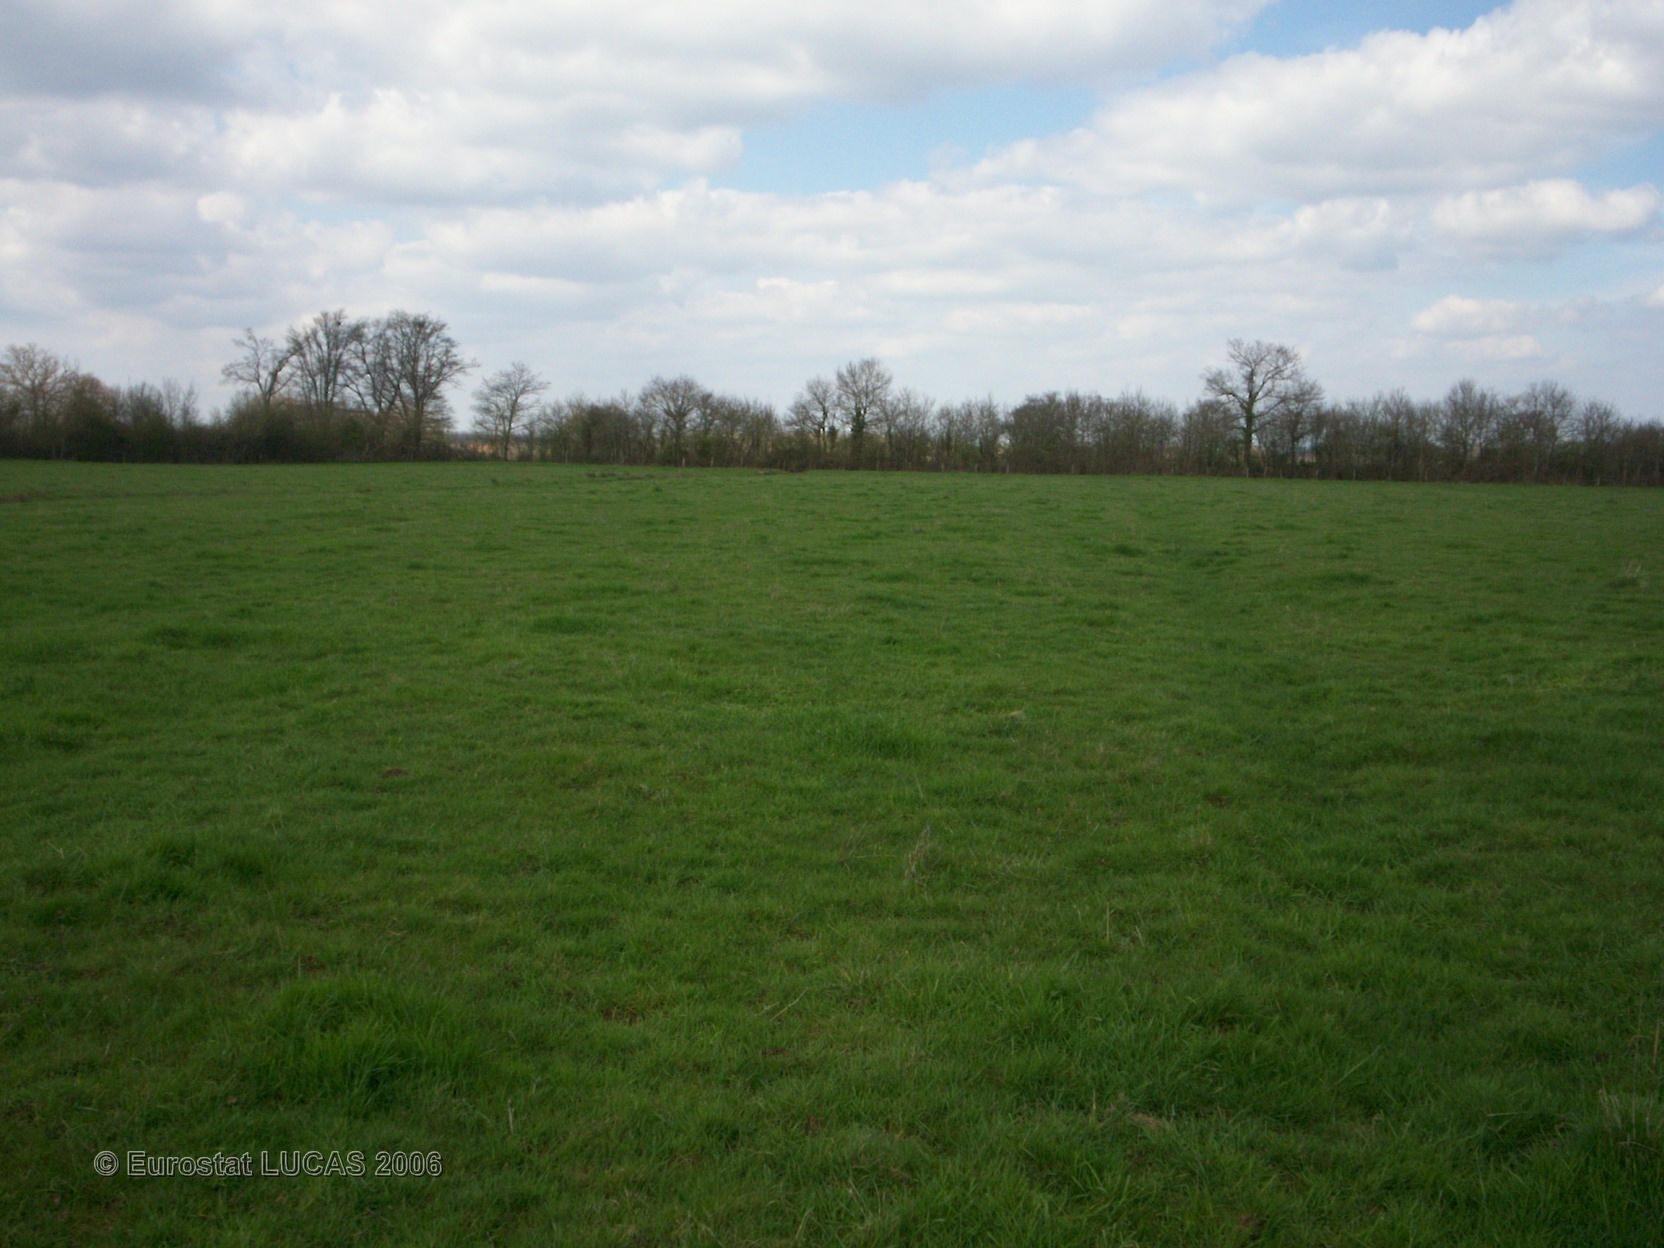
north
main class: Grassland
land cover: Grassland without tree/shrub cover
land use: Agriculture (excluding fallow land and kitchen gardens)
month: April
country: FR
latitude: 46.7948
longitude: 3.0660
